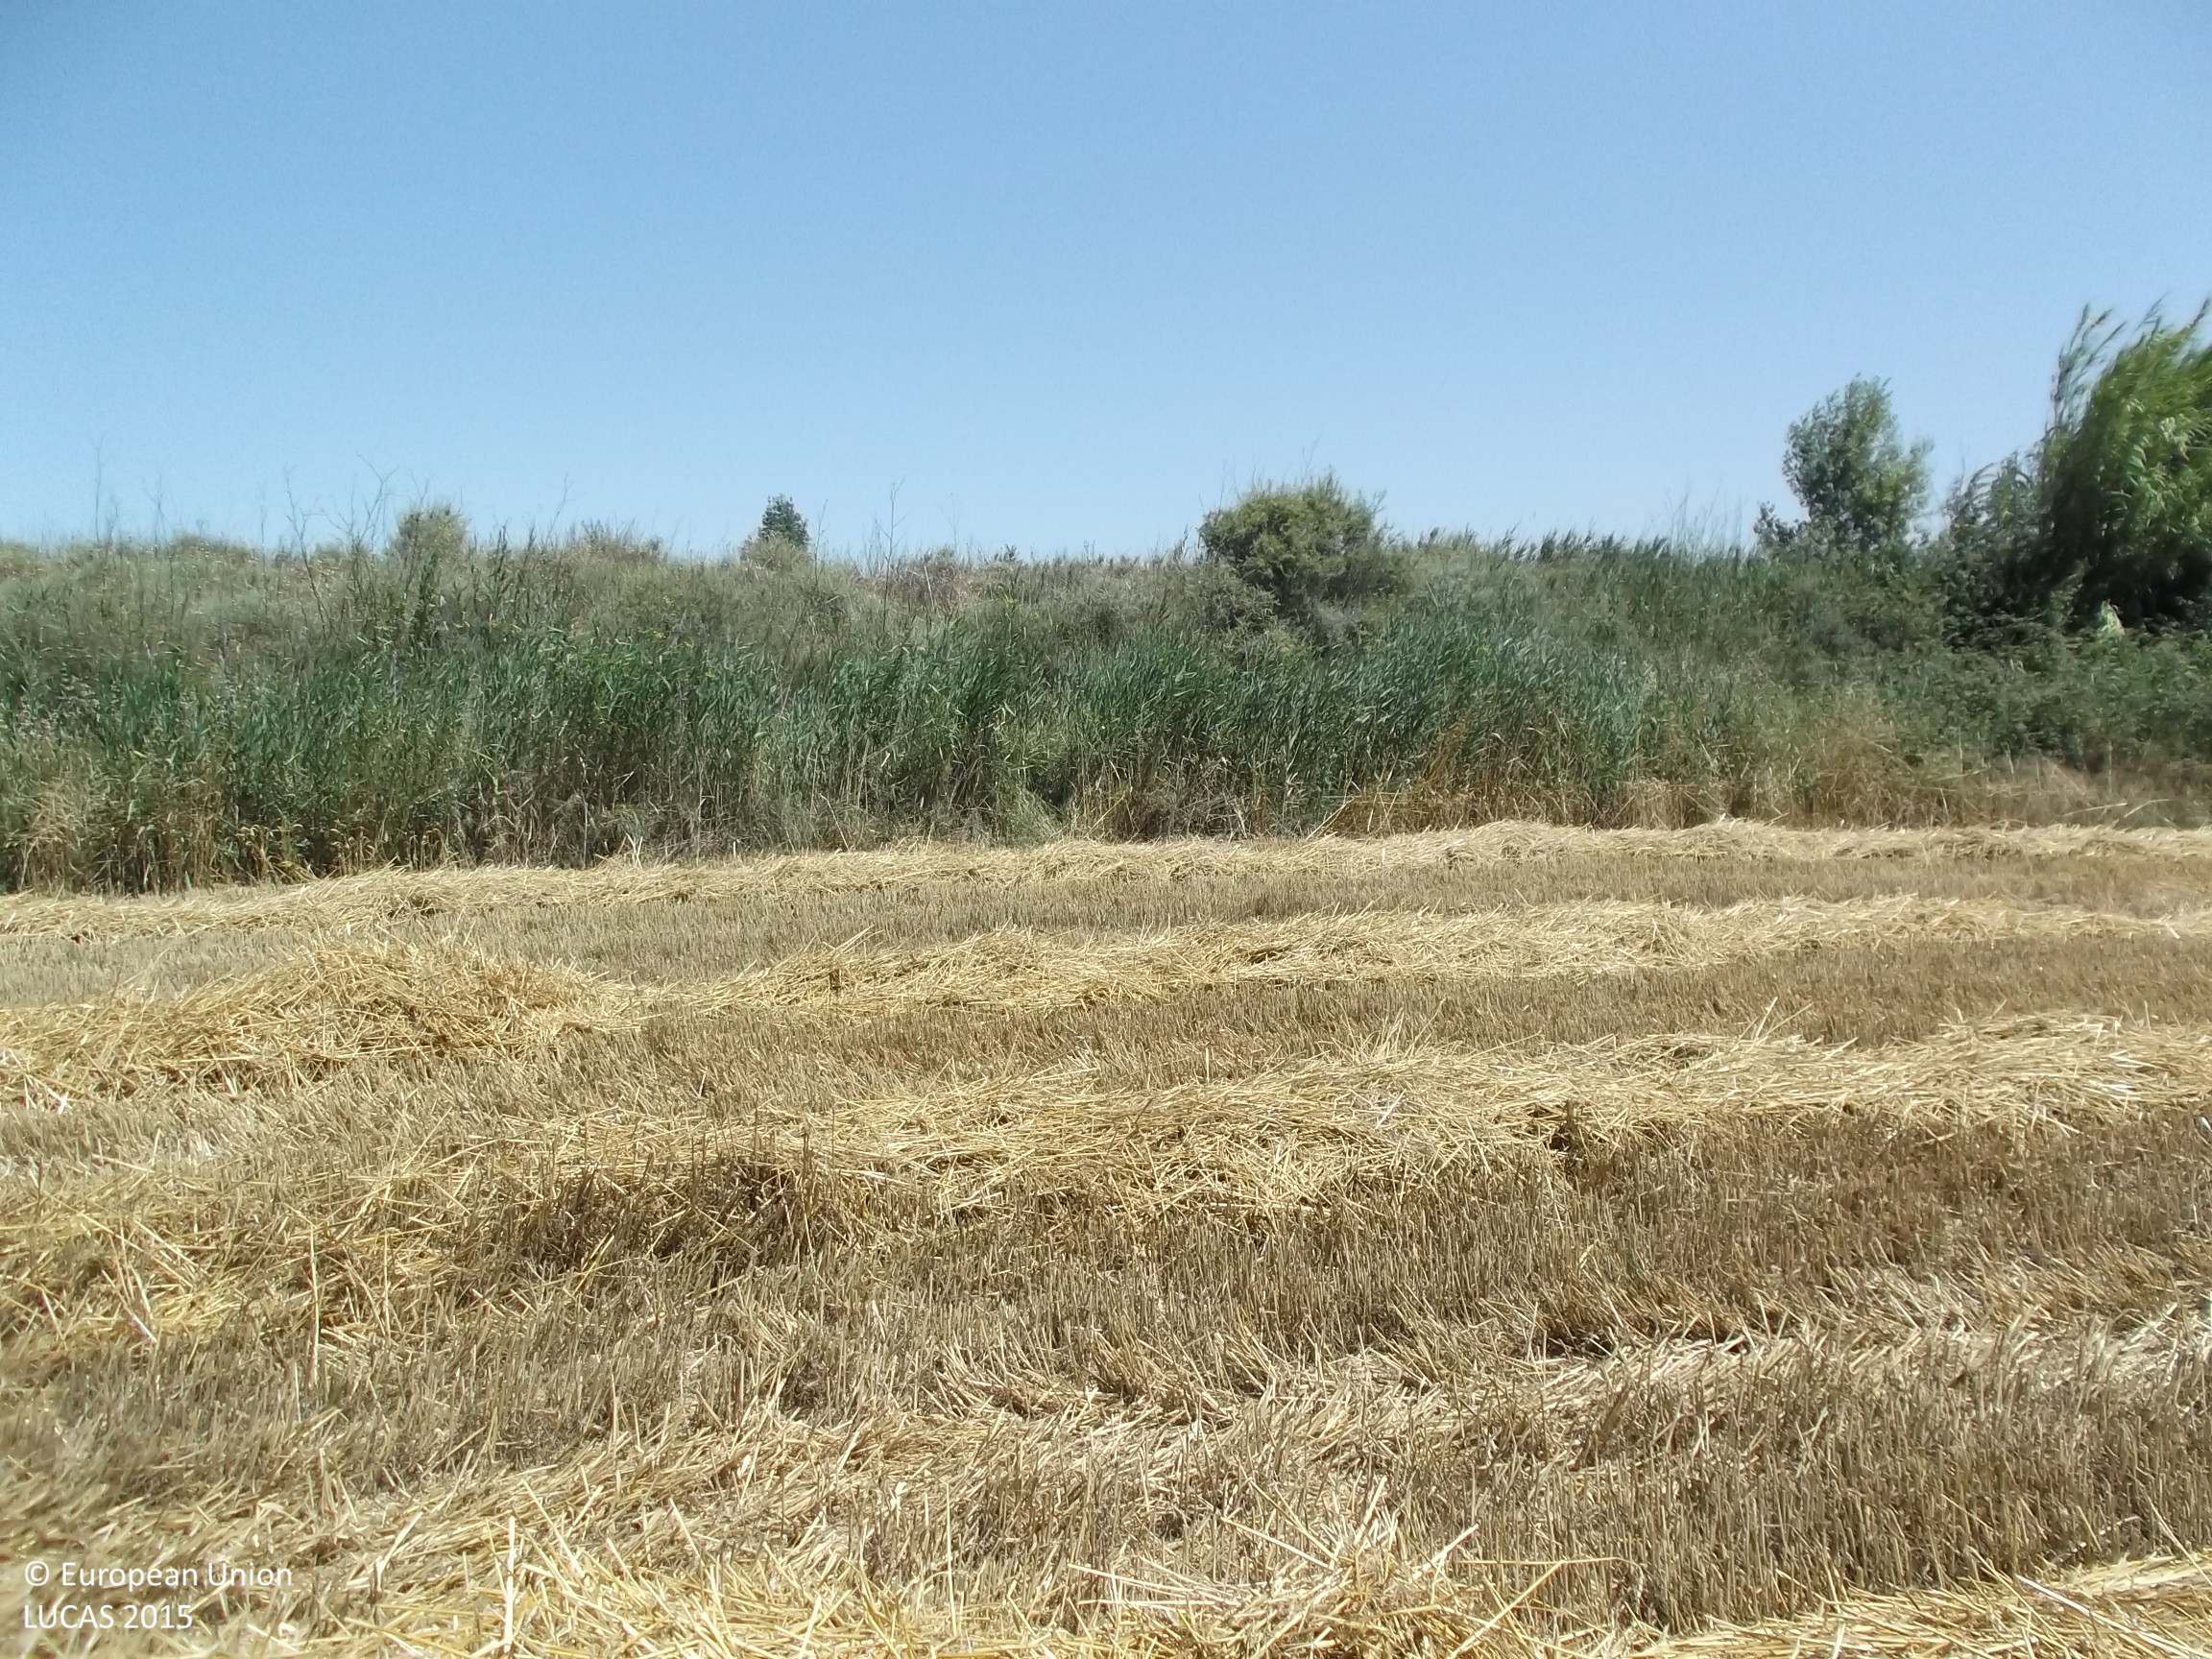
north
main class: Cropland
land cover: Common wheat
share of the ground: < 10 %
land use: Agriculture (excluding fallow land and kitchen gardens)
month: July
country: ES
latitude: 42.3699
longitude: -1.5828
